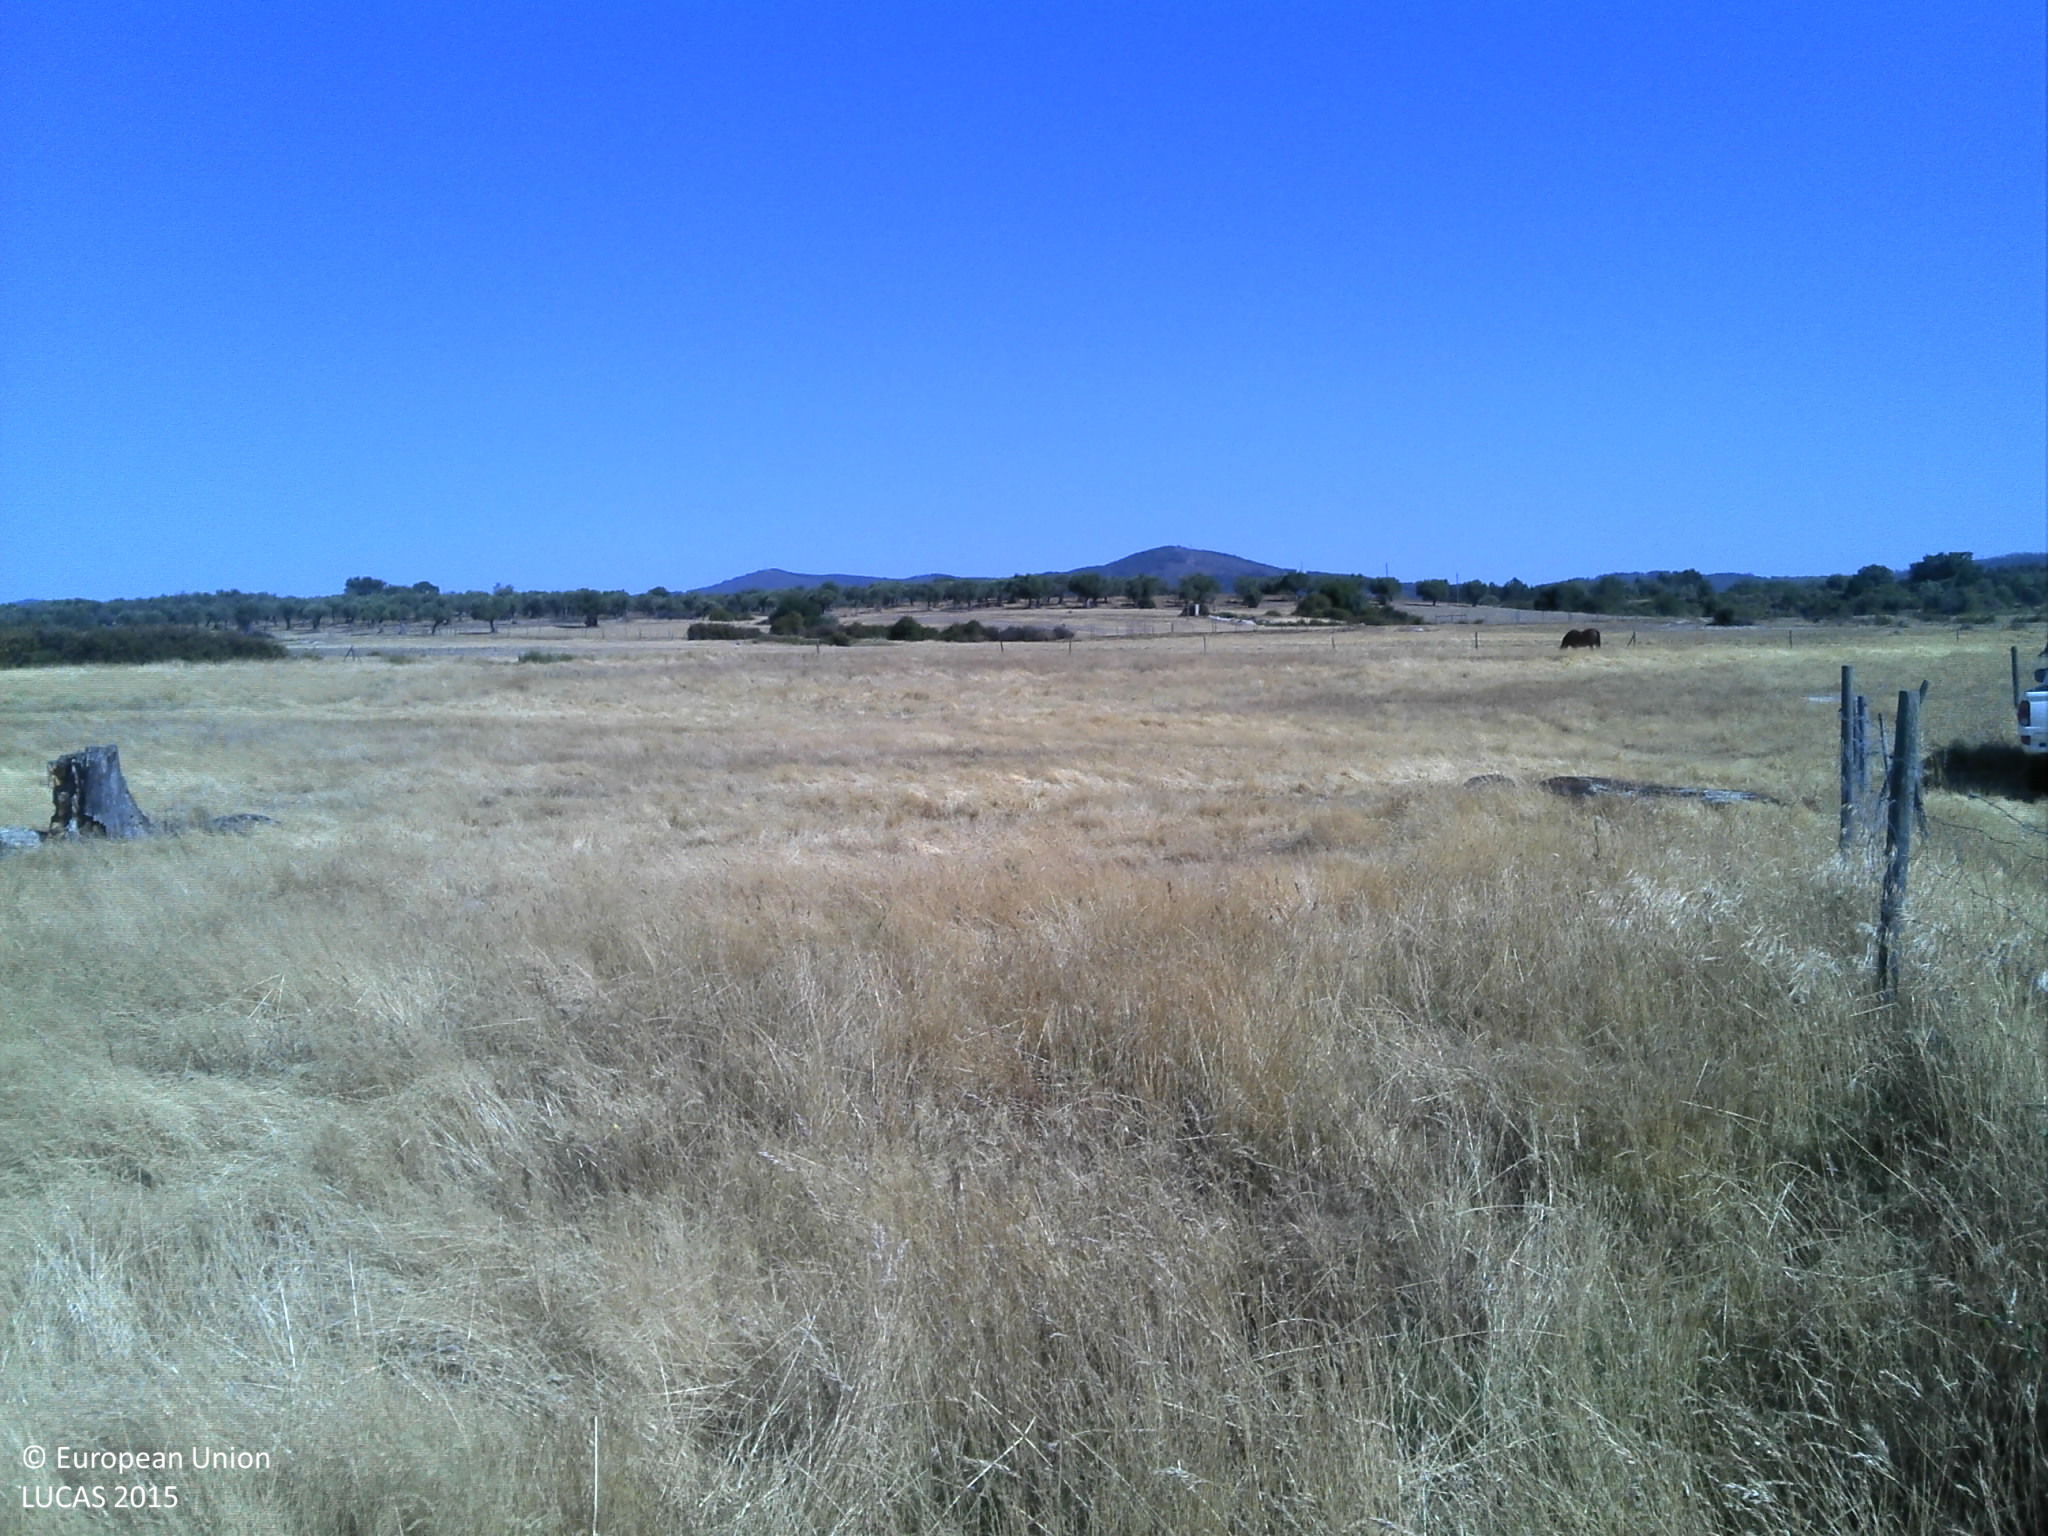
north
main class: Grassland
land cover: Grassland without tree/shrub cover
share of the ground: 50 - 75 %
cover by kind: herbaceous plants 60 %, unconsolidated bare surface 35 %
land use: Agriculture (excluding fallow land and kitchen gardens)
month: June
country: PT
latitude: 40.0739
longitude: -7.3488
